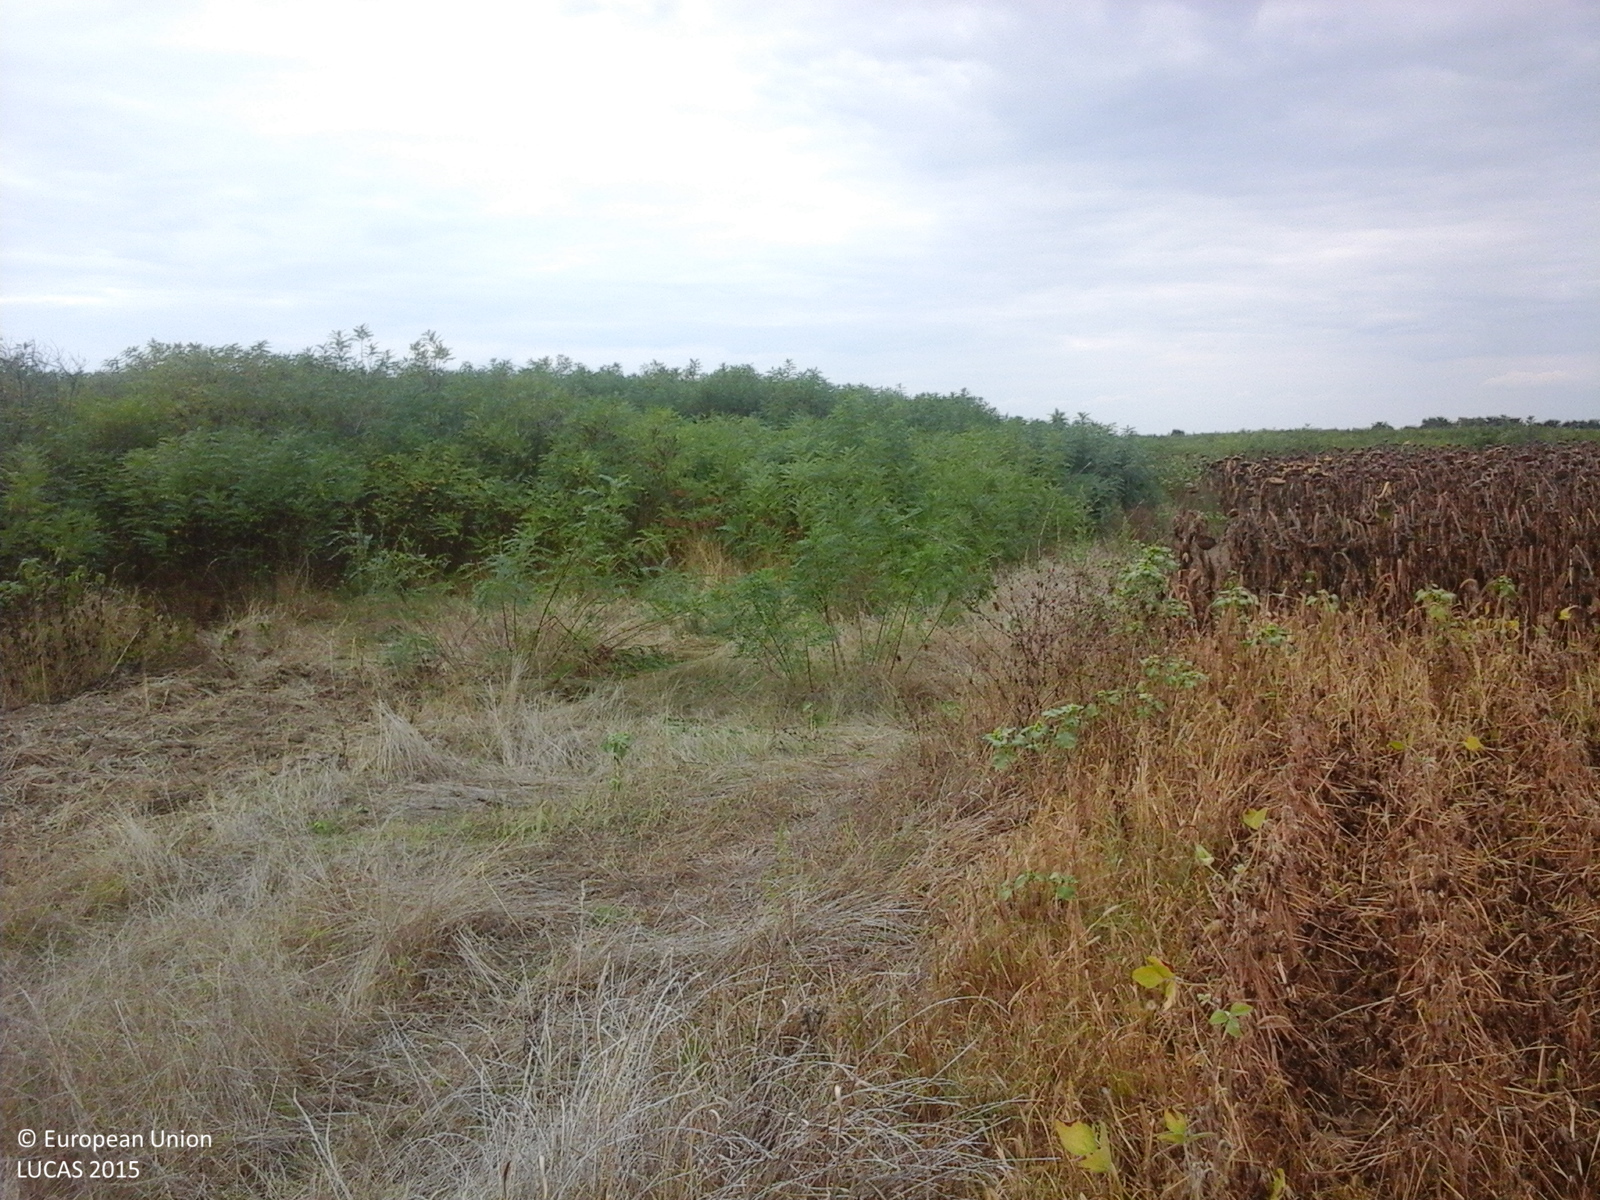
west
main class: Cropland
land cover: Soya
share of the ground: > 75 %
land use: Agriculture (excluding fallow land and kitchen gardens)
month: September
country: RO
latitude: 47.7236
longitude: 23.1473
